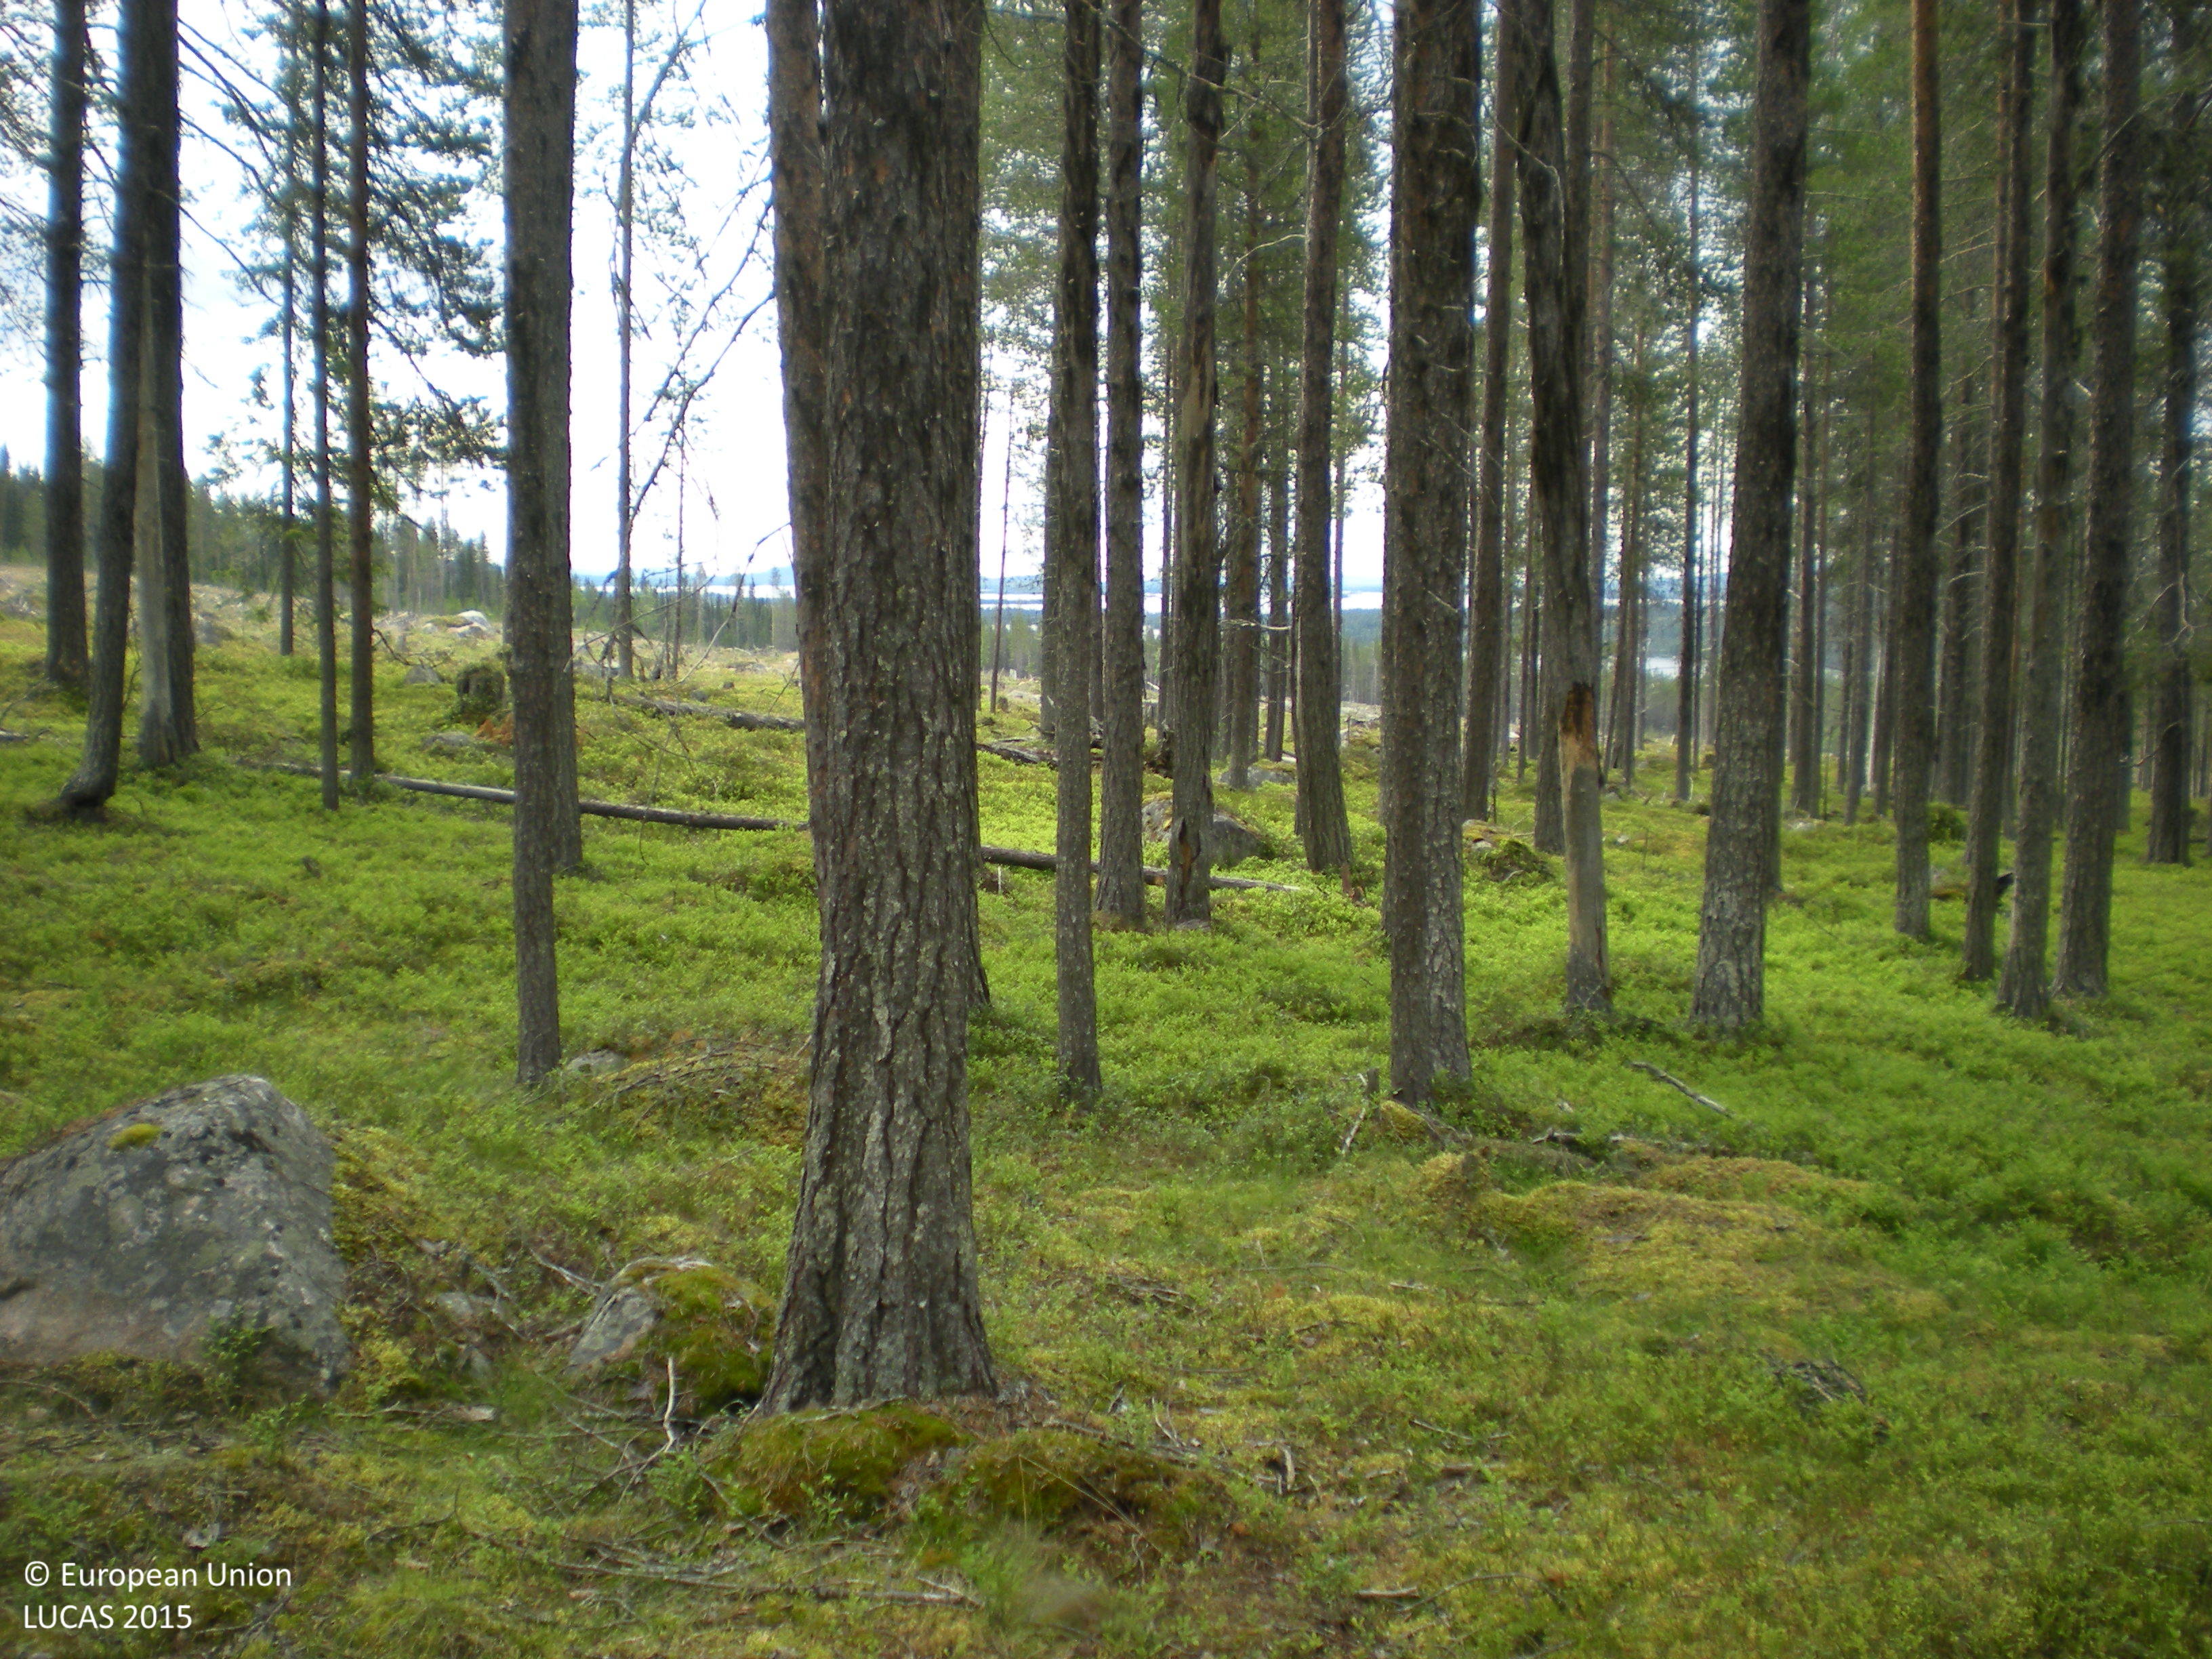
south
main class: Woodland
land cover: Pine dominated coniferous woodland
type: boreal forest
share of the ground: 50 - 75 %
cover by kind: coniferous forest trees 65 %, shrubs 25 %, lichens and mosses 5 %, consolidated bare surface 5 %
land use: Forestry
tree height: > 5 m
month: July
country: SE
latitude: 65.8042
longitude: 18.2007
